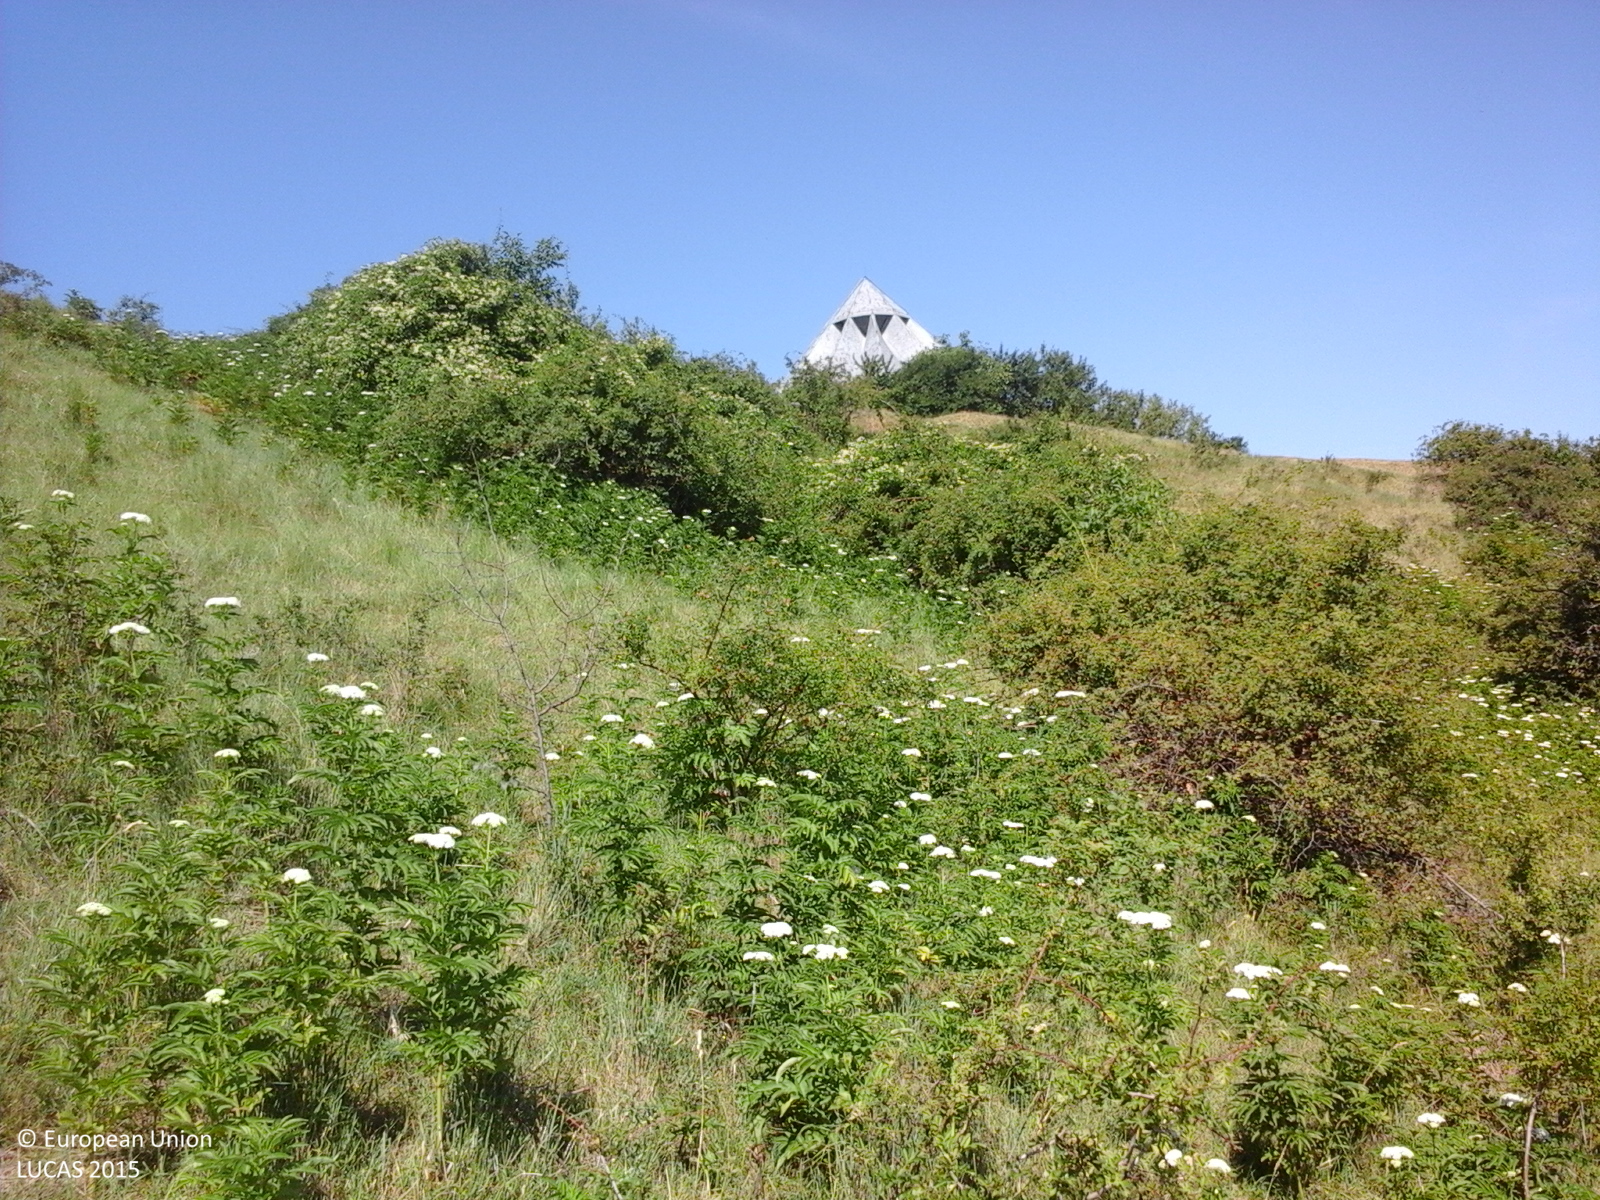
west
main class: Shrubland
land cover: Shrubland without tree cover
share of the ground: > 75 %
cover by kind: shrubs 80 %, herbaceous plants 20 %
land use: Fallow land
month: June
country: RO
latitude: 47.2871
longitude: 26.9313
